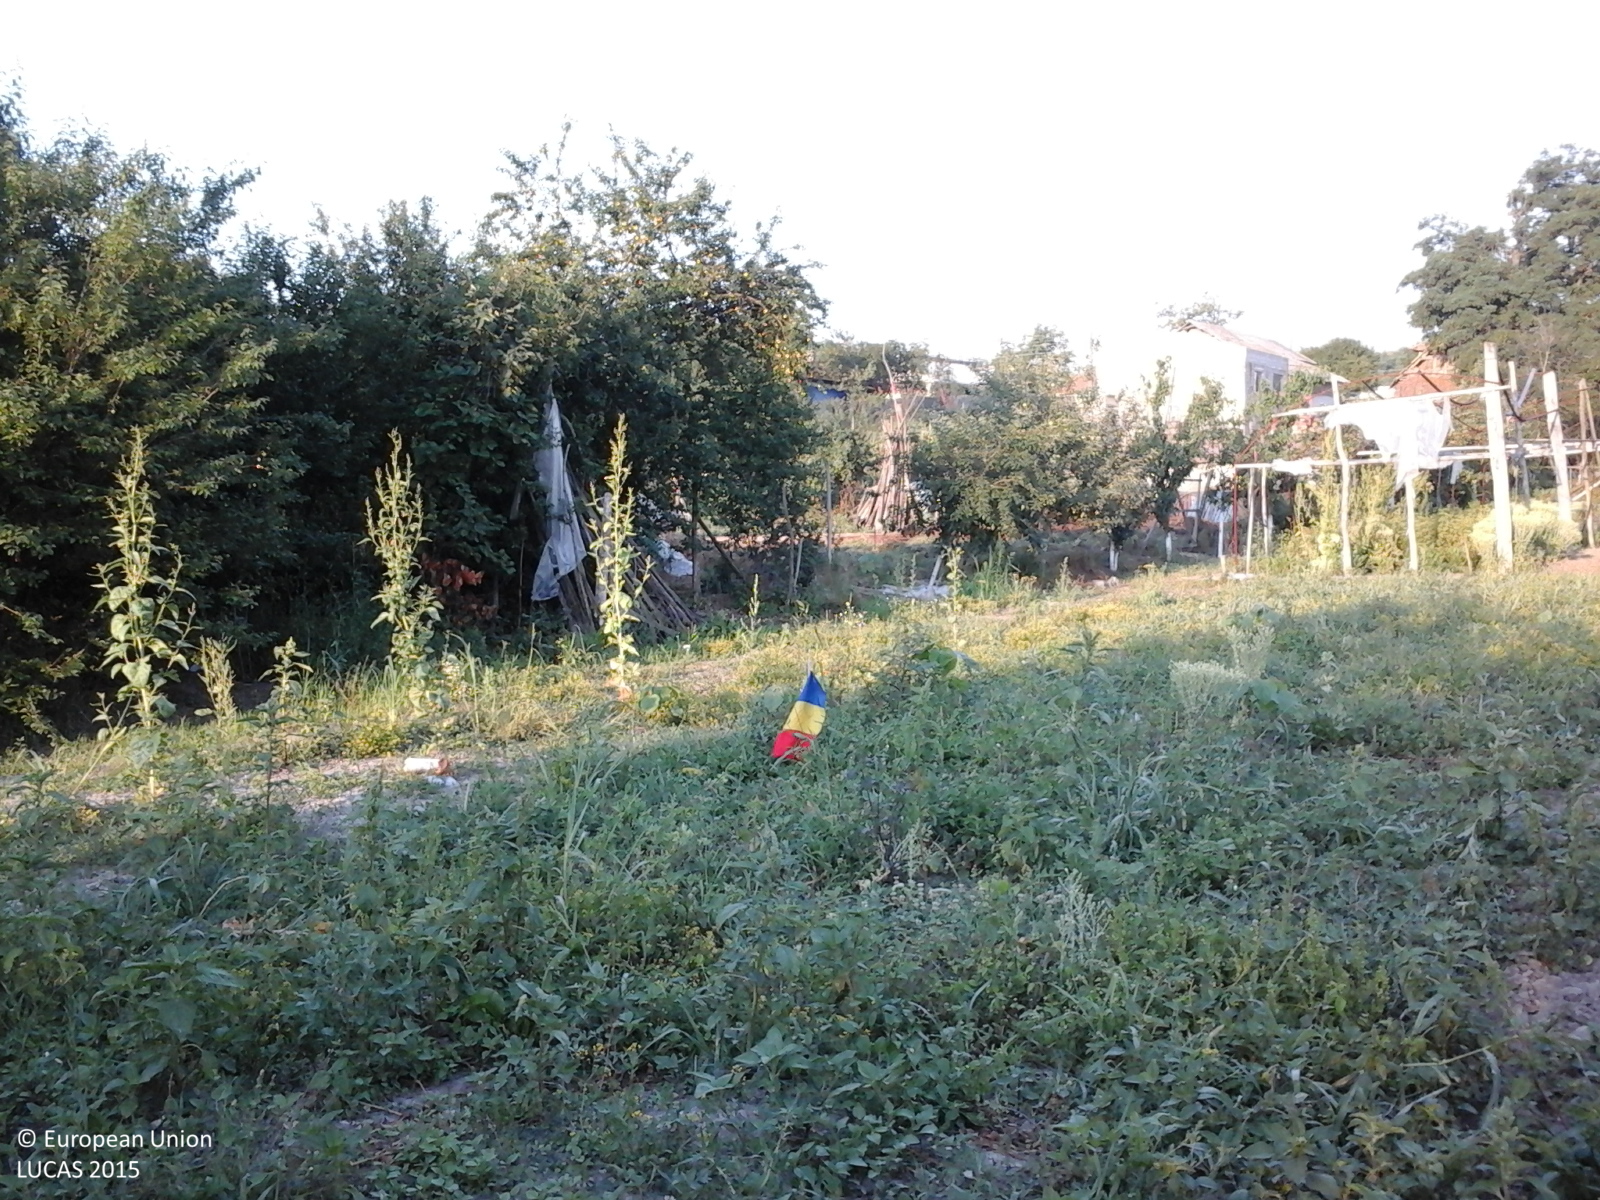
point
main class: Grassland
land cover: Spontaneously vegetated surfaces
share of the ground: 50 - 75 %
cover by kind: herbaceous plants 65 %, unconsolidated bare surface 35 %
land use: Agriculture (excluding fallow land and kitchen gardens)
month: July
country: RO
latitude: 44.5859
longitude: 24.6477
